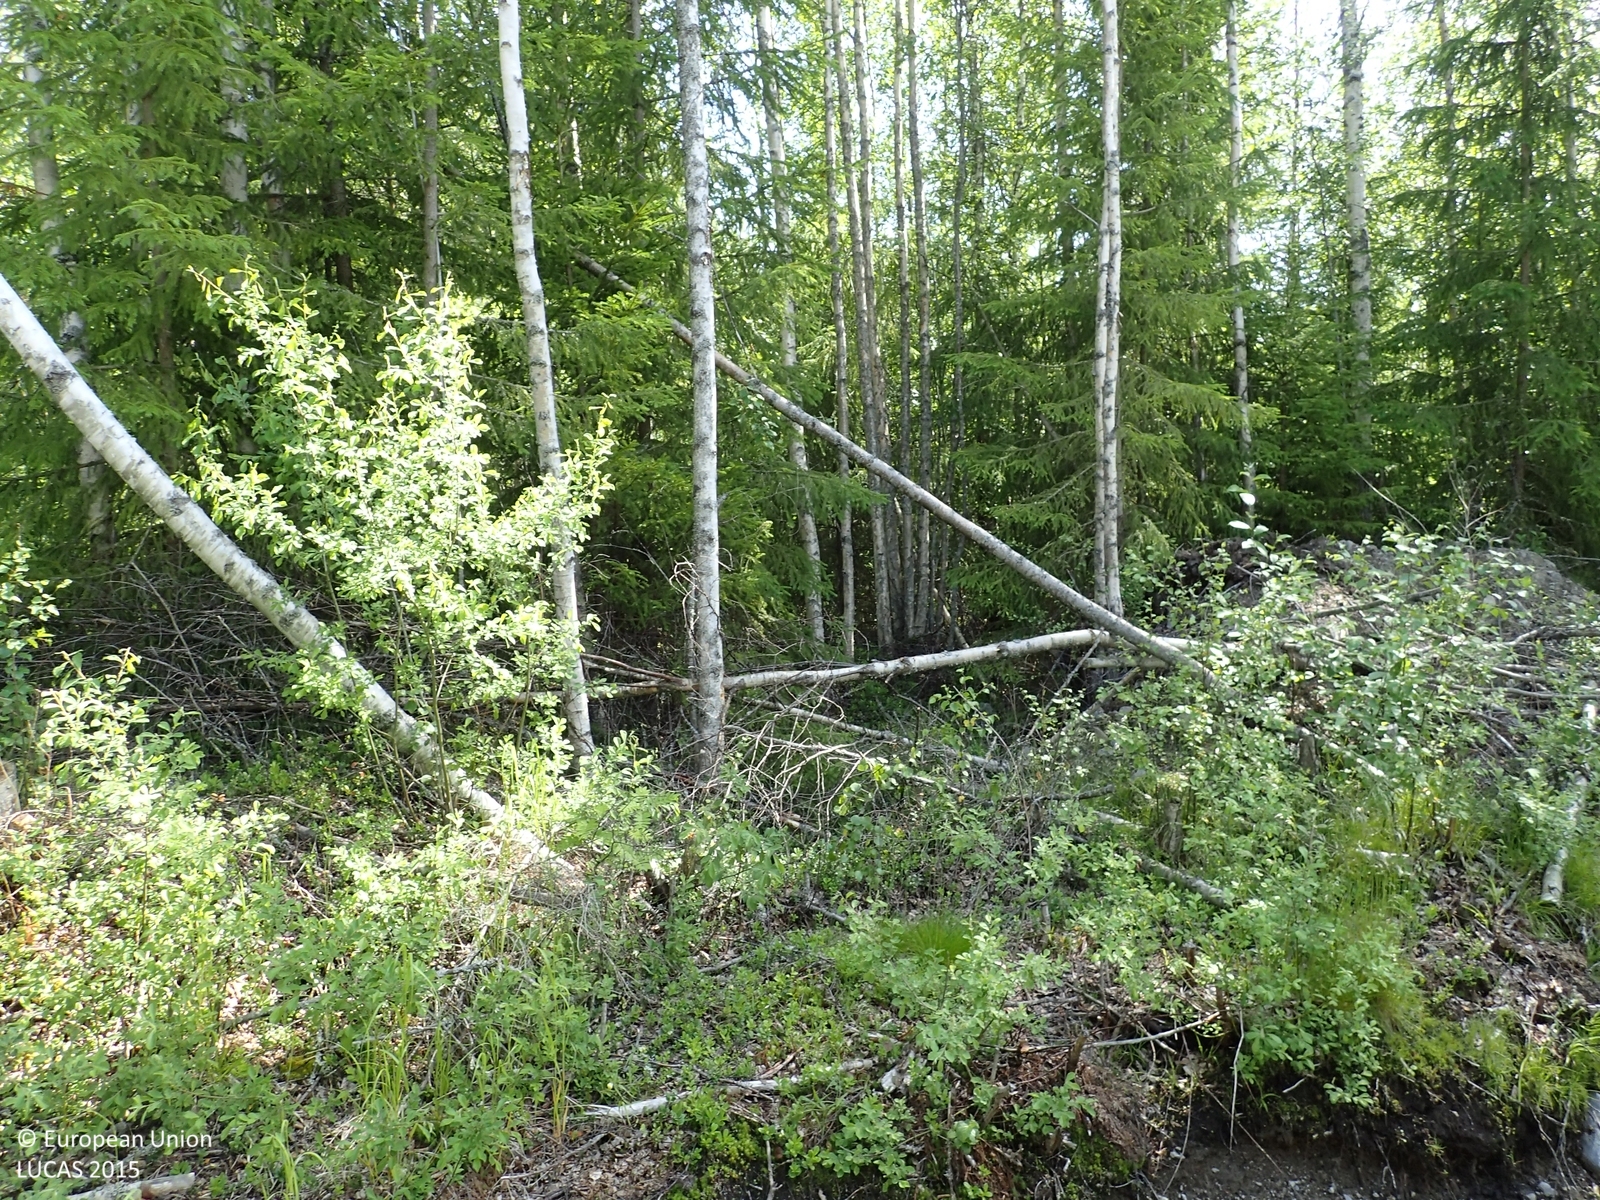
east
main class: Woodland
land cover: Spruce dominated mixed woodland
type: boreal forest
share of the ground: > 75 %
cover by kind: coniferous forest trees 45 %, broadleaved forest trees 40 %, shrubs 10 %, herbaceous plants 5 %
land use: Forestry
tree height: > 5 m
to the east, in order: Spruce dominated mixed woodland; Ditches and canals; Other mixed woodland; Pine dominated coniferous woodland; Spruce dominated mixed woodland; Tracks; Pine dominated mixed woodland
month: July
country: FI
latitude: 62.7726
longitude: 21.5023
